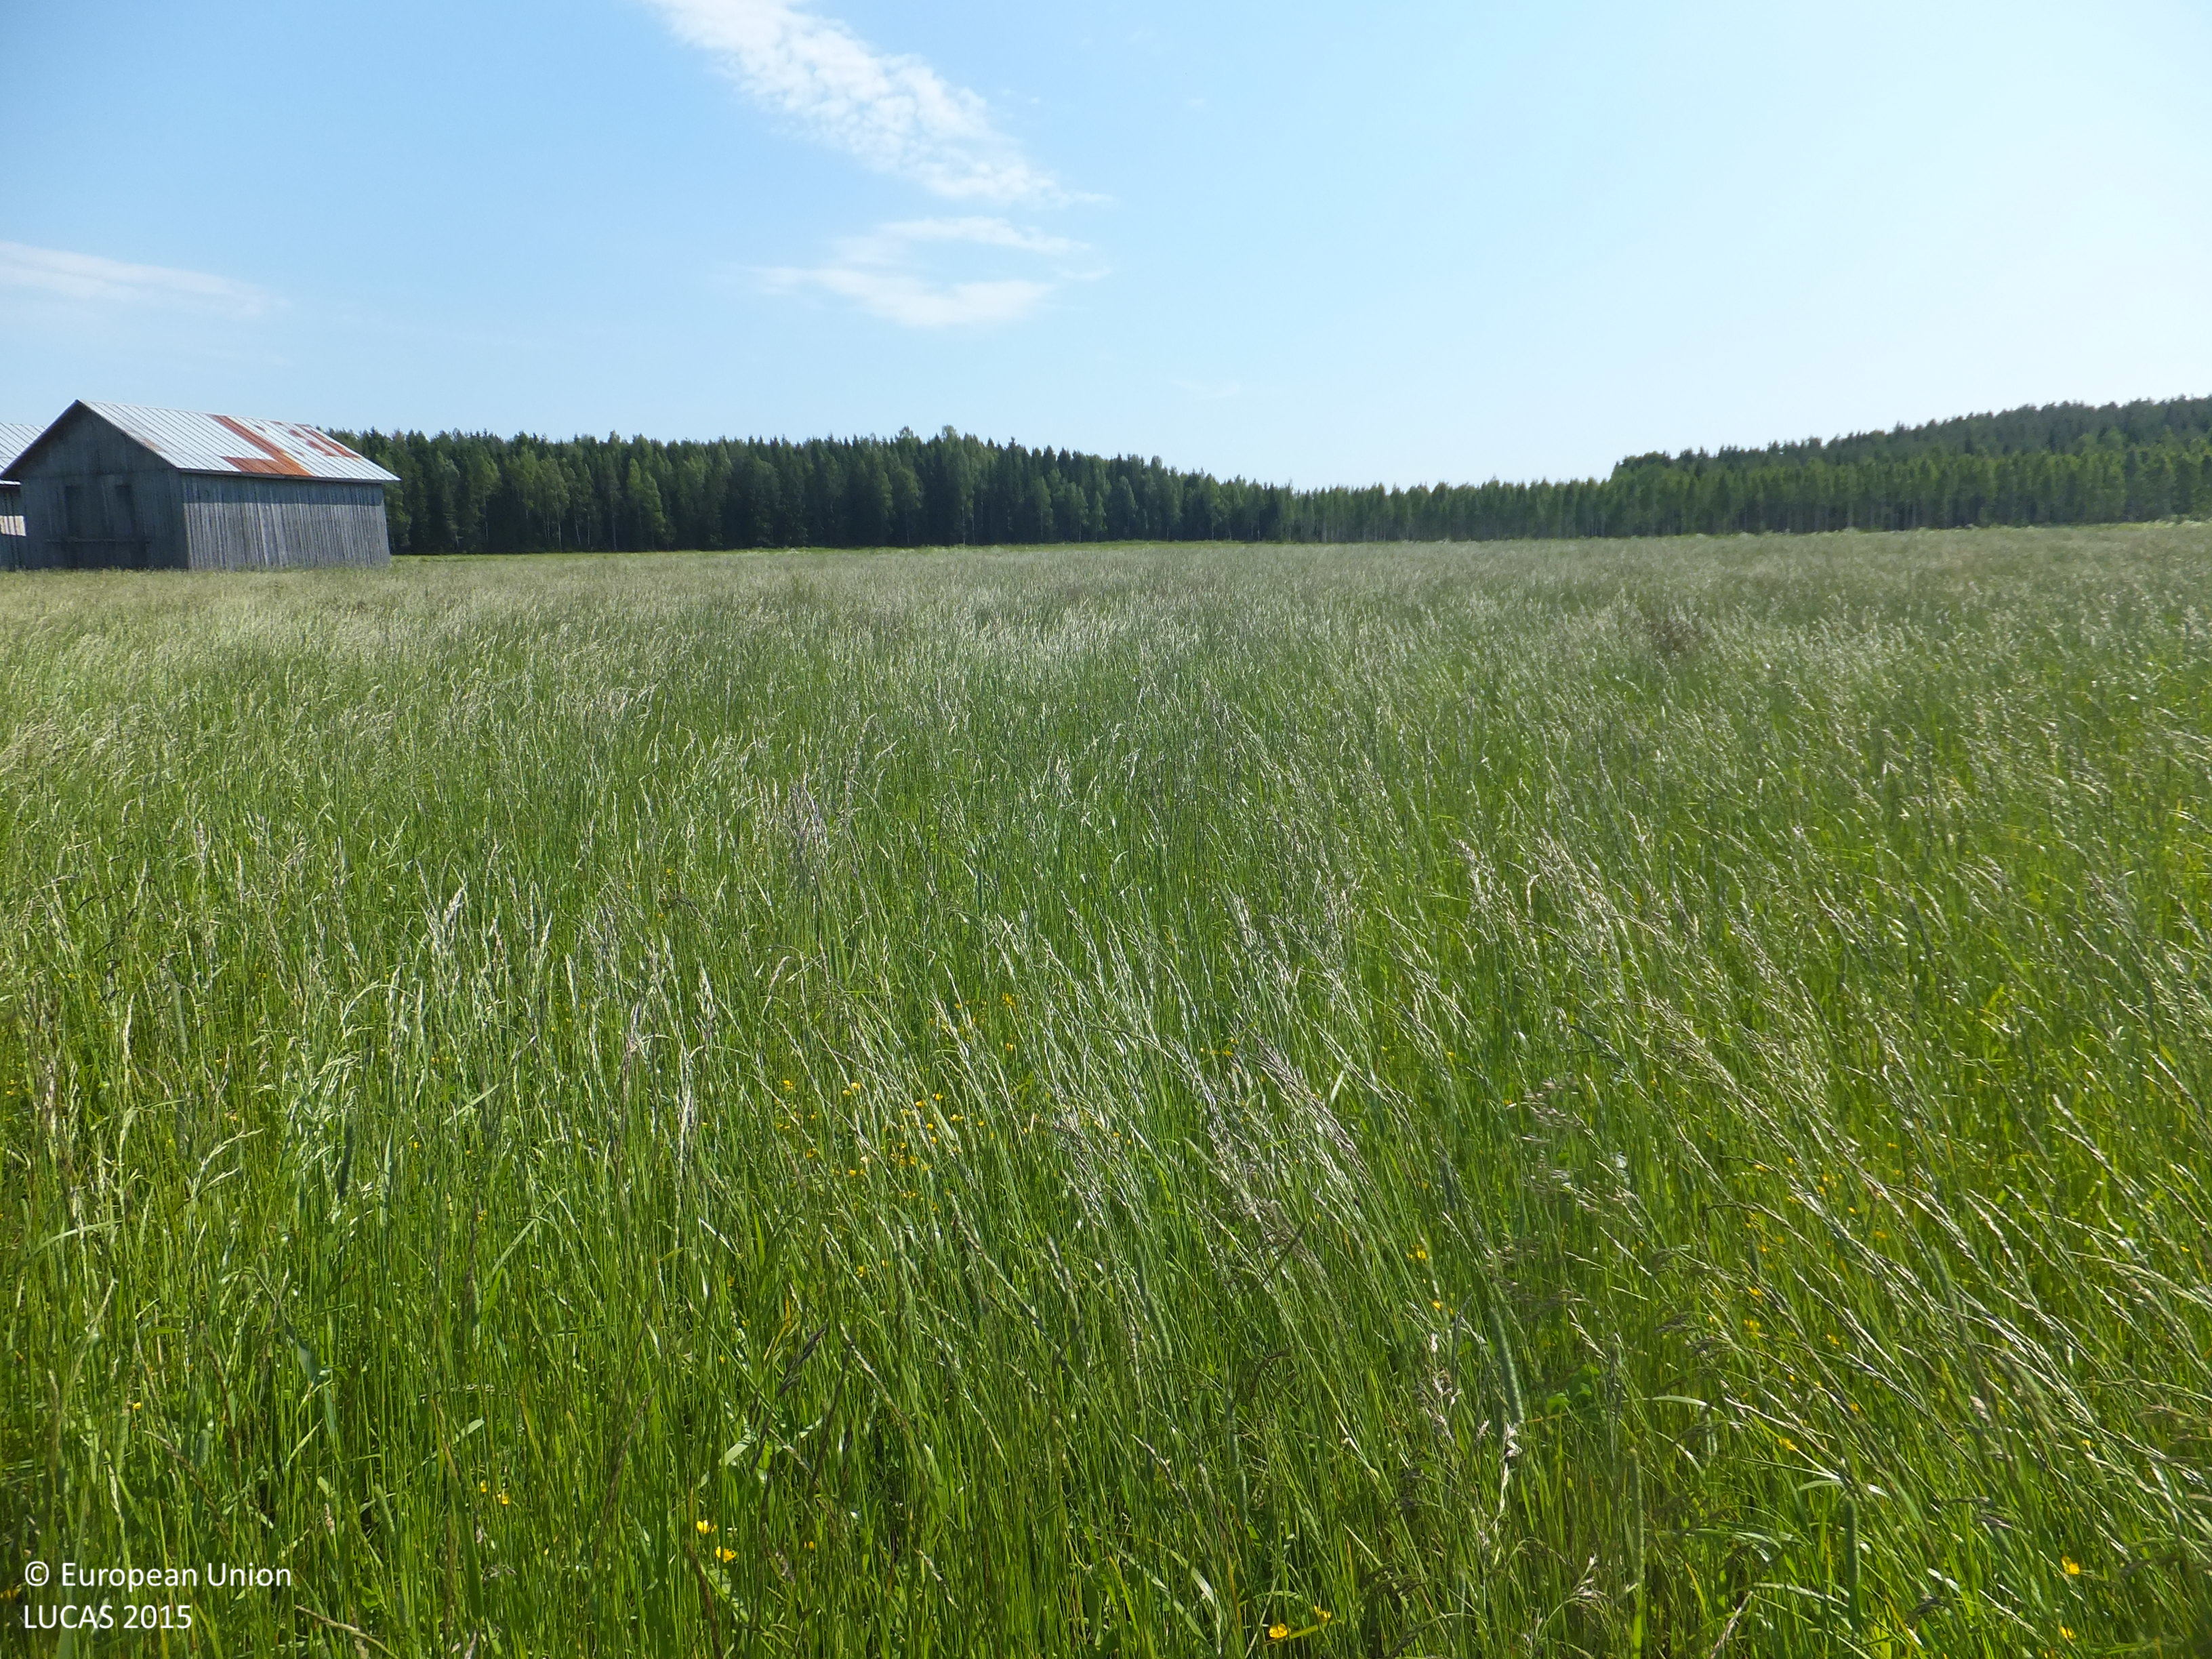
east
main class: Cropland
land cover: Temporary grasslands
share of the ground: > 75 %
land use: Agriculture (excluding fallow land and kitchen gardens)
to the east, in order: Temporary grasslands; Ditches and canals; Grass margins; Common wheat; Grass margins; Ditches and canals; Grass margins; Temporary grasslands
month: July
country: FI
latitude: 63.2413
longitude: 23.7859
